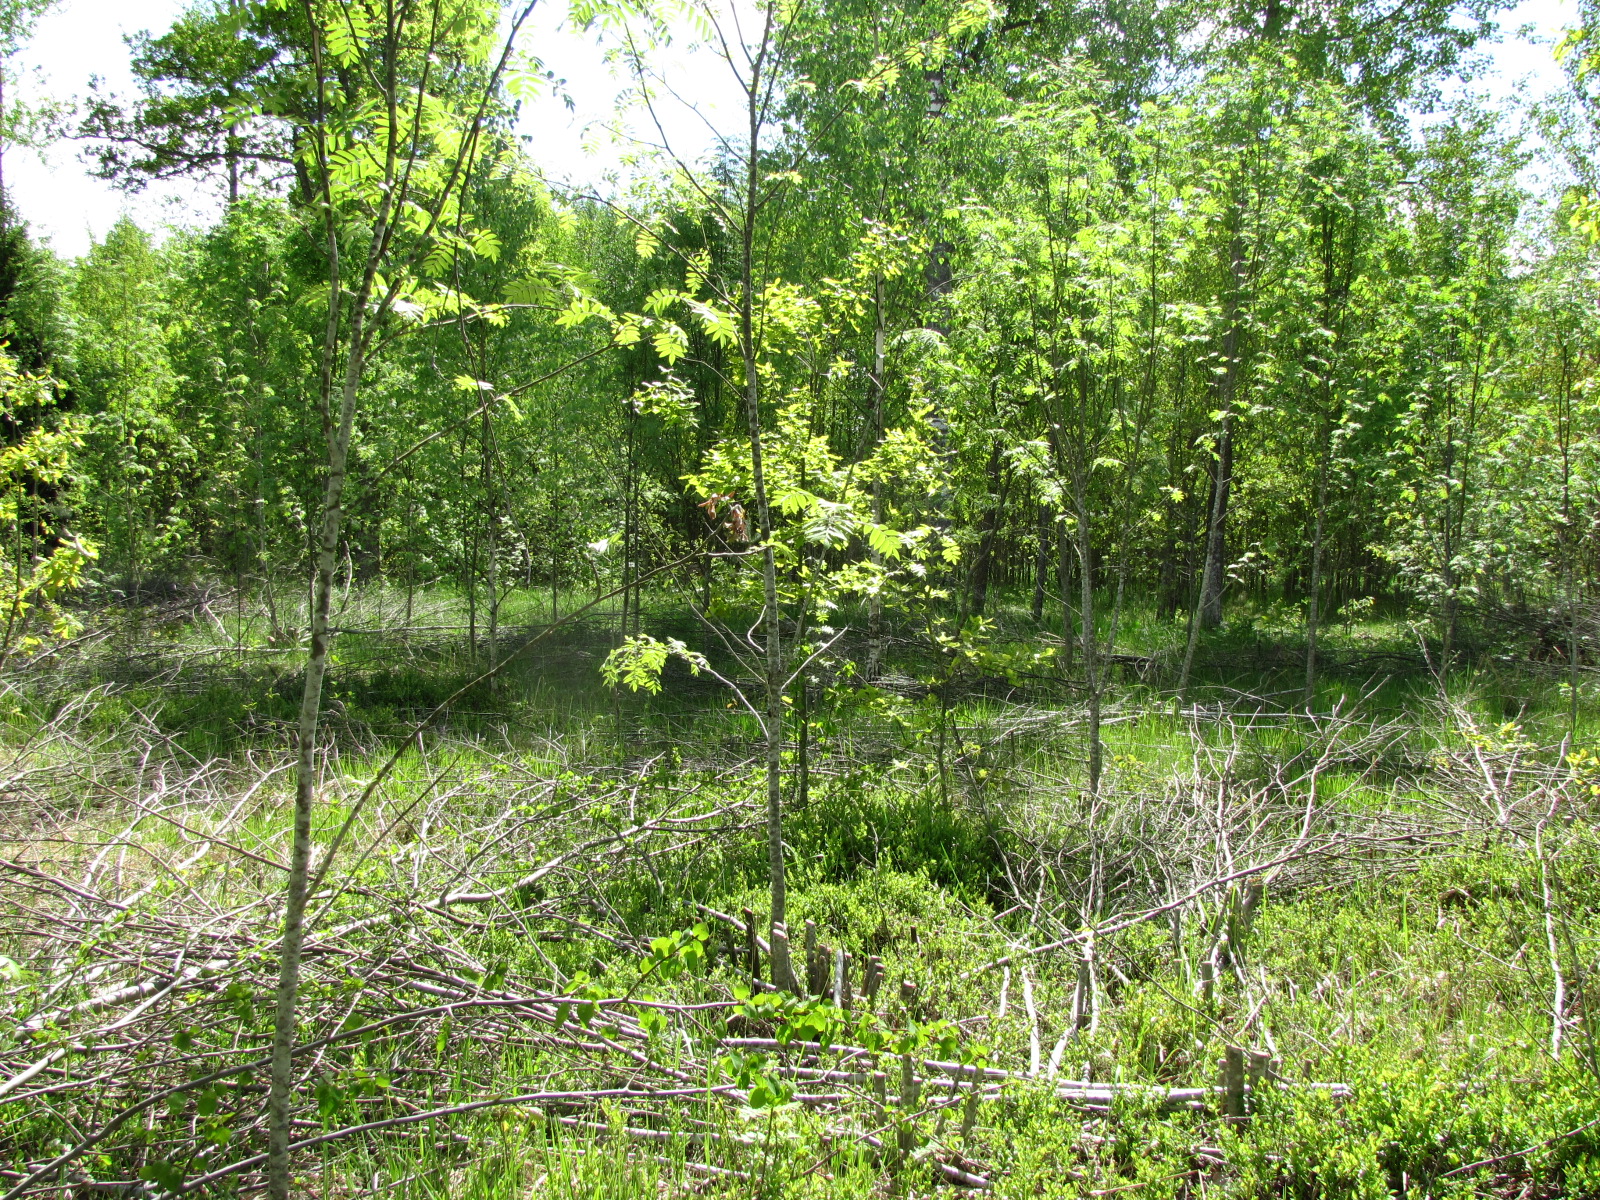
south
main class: Woodland
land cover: Broadleaved woodland
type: non-riverine alder, birch or aspen forest
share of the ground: 50 - 75 %
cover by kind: broadleaved forest trees 60 %, herbaceous plants 40 %
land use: Forestry
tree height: > 5 m
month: May
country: LV
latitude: 56.6478
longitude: 23.9292
